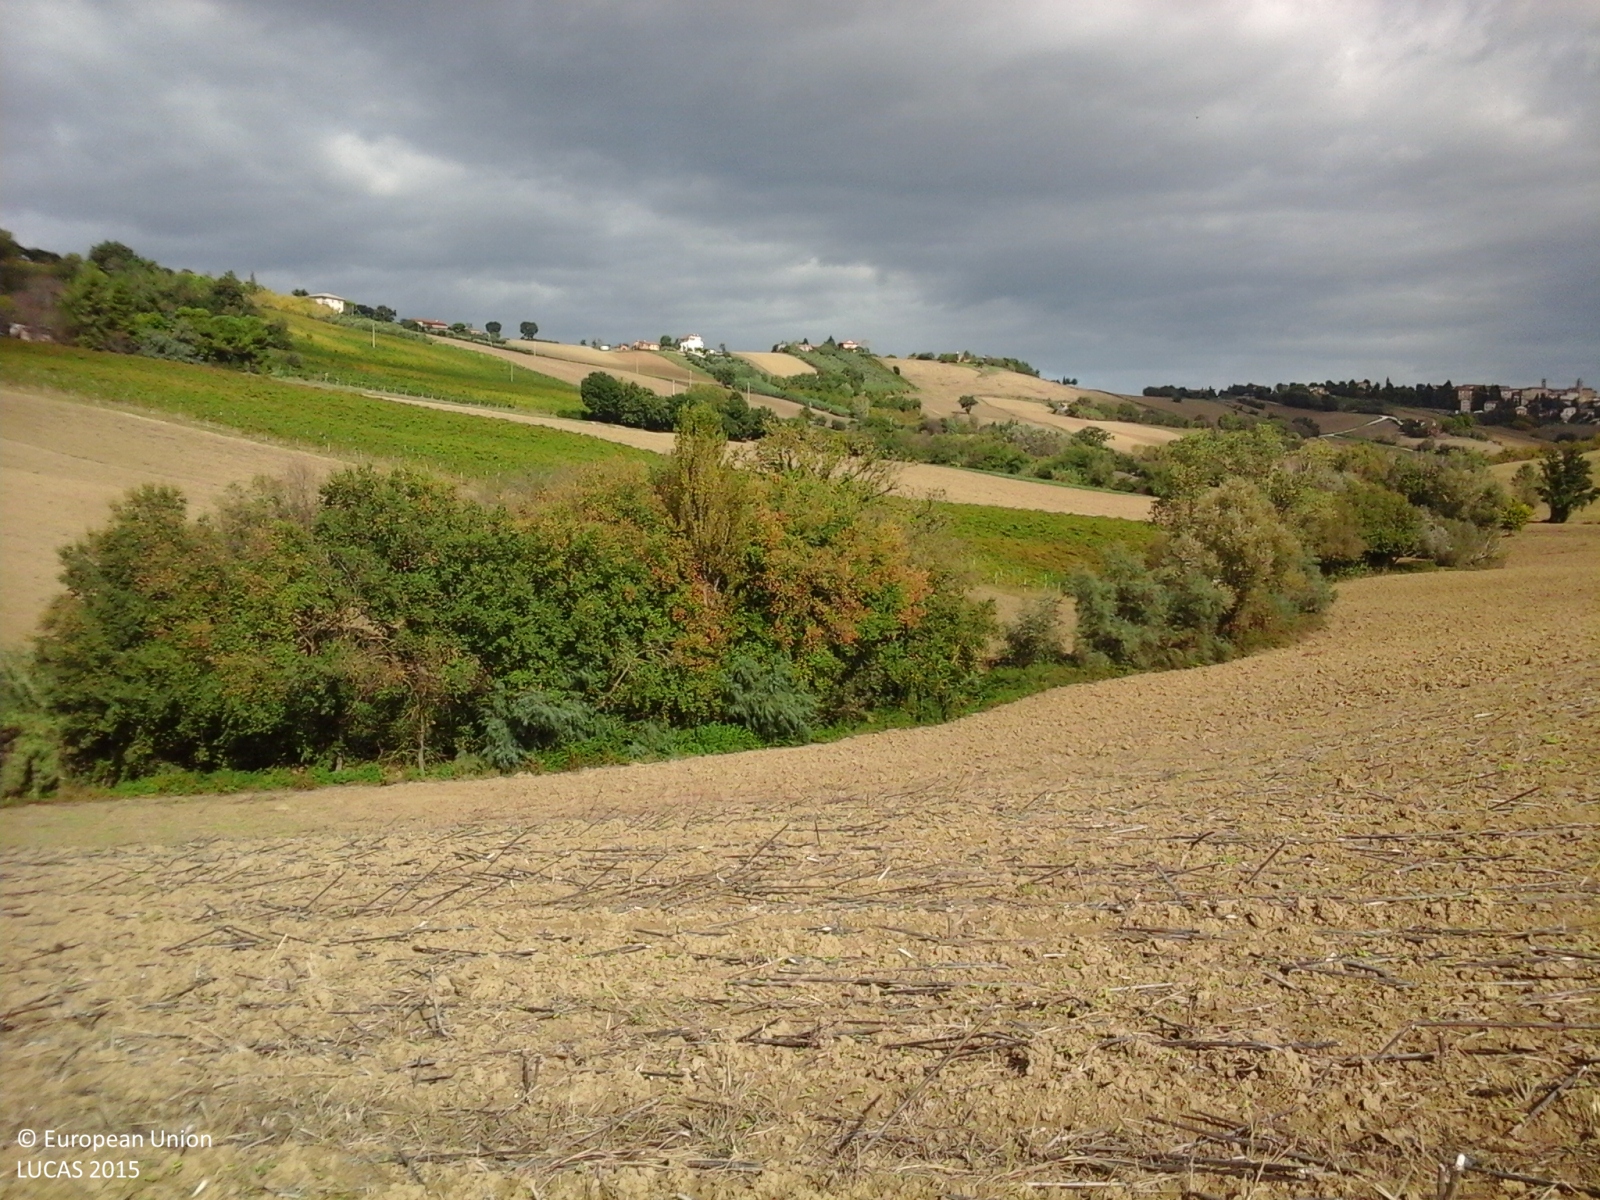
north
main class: Cropland
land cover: Sunflower
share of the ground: < 10 %
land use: Agriculture (excluding fallow land and kitchen gardens)
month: October
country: IT
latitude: 43.5611
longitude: 13.1986
